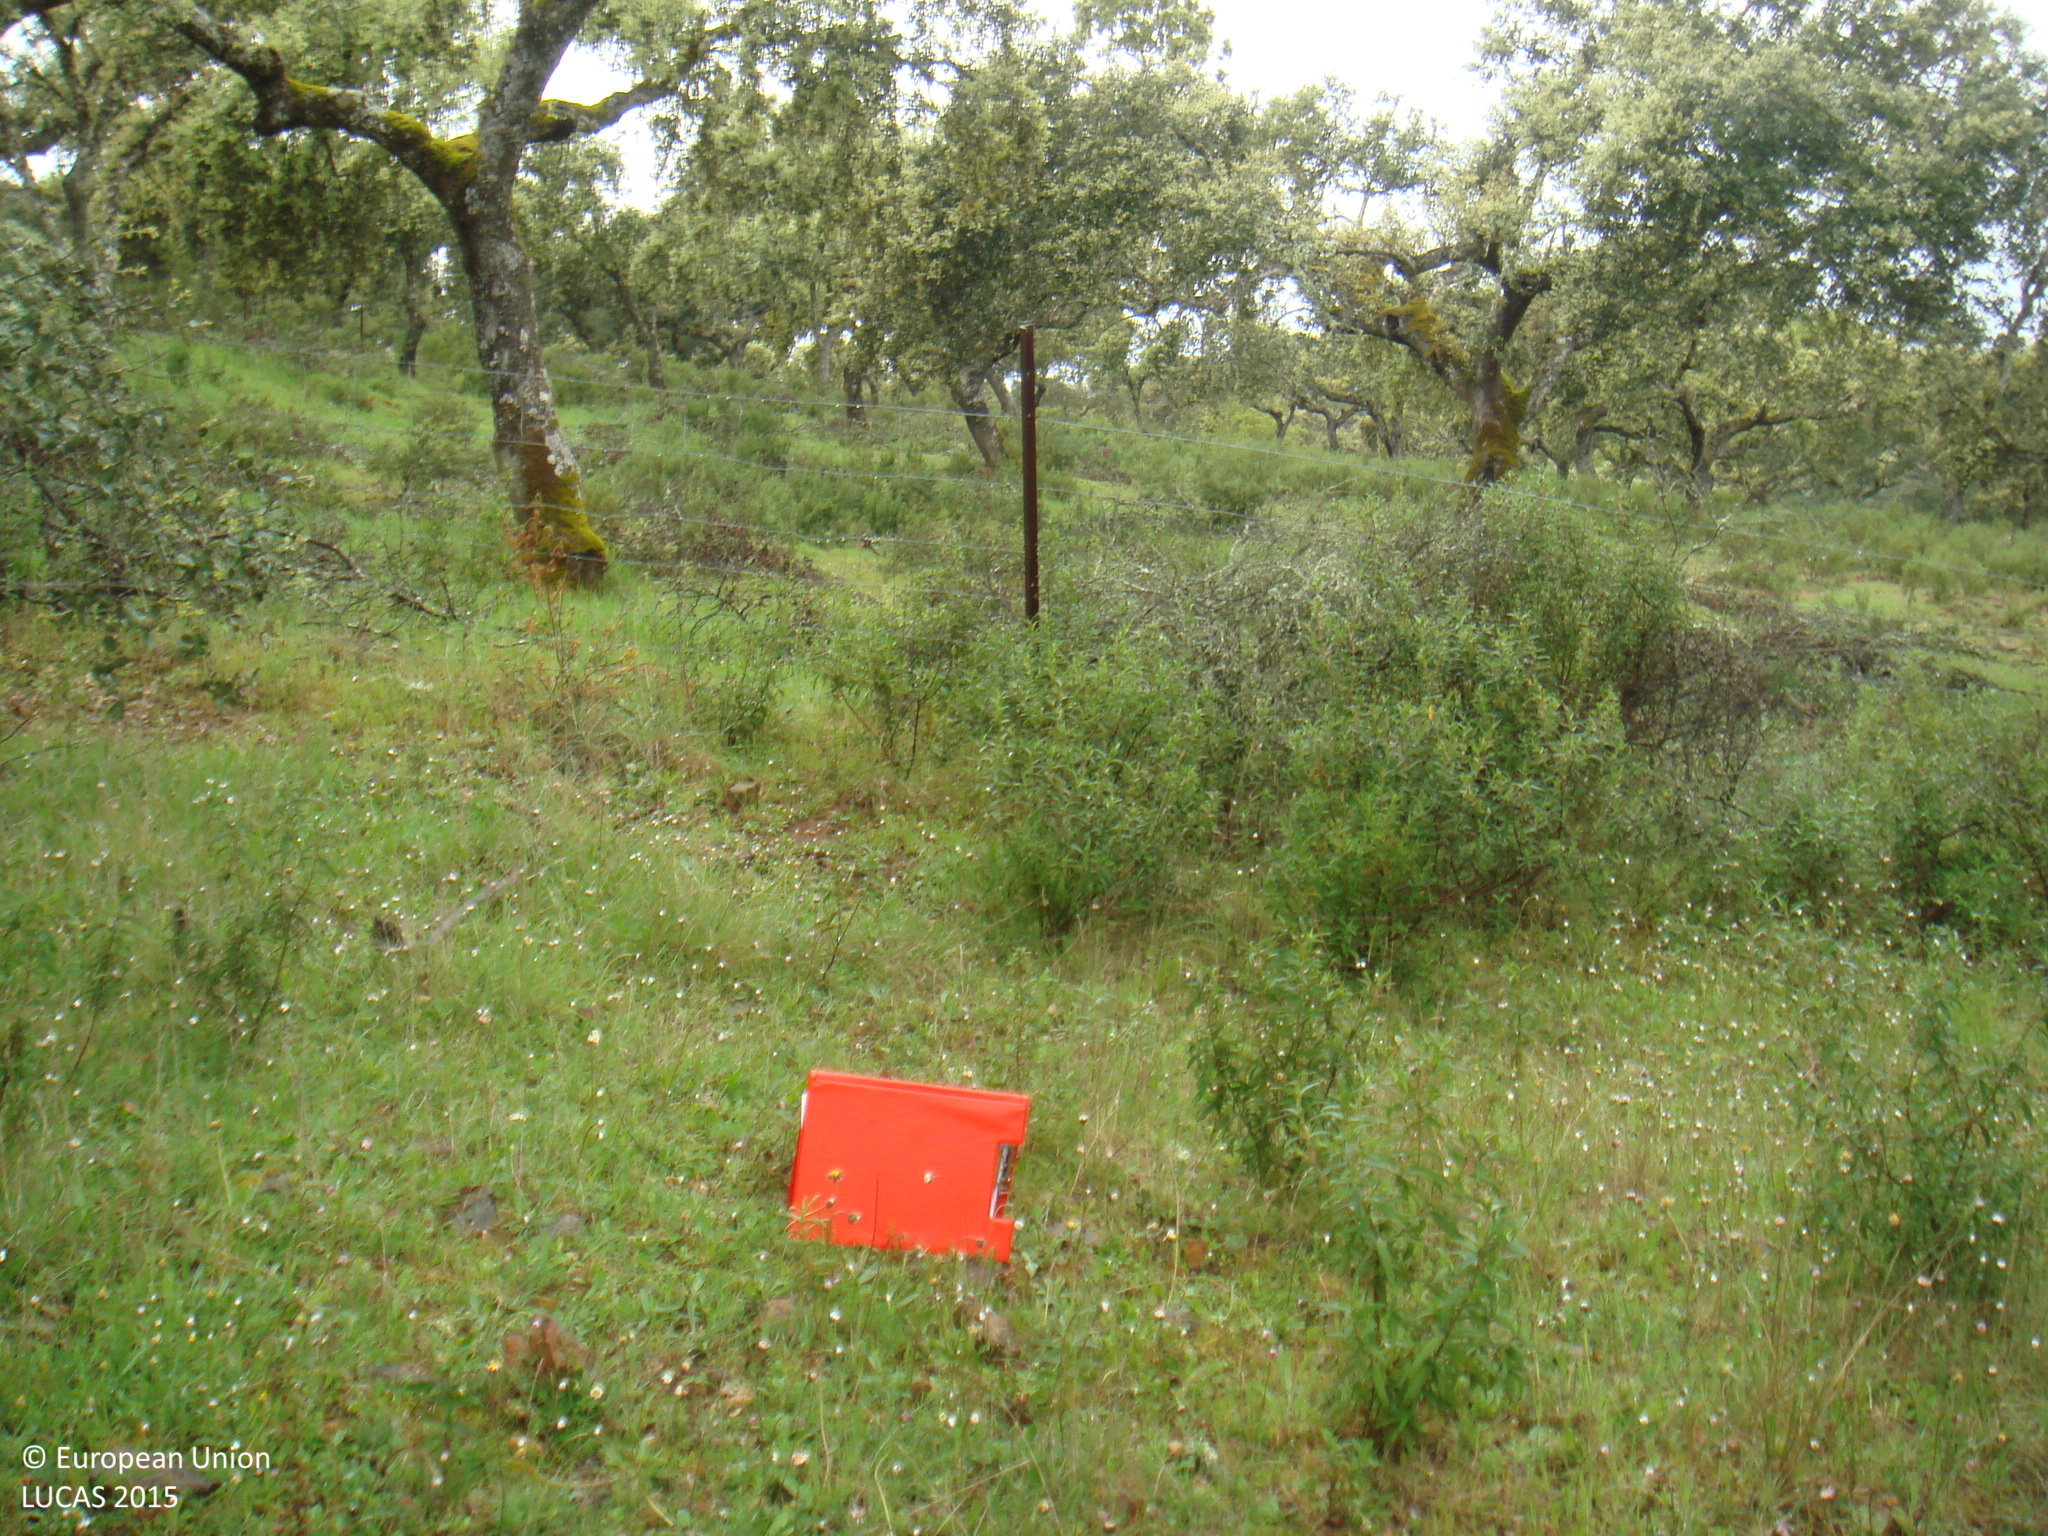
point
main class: Woodland
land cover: Broadleaved woodland
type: broadleaved evergreen forest
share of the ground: 50 - 75 %
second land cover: Spontaneously vegetated surfaces
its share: 50 - 75 %
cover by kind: broadleaved forest trees 60 %, herbaceous plants 30 %, shrubs 10 %
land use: Forestry
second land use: Agriculture (excluding fallow land and kitchen gardens)
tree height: > 5 m
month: April
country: ES
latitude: 38.1925
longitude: -5.3159
